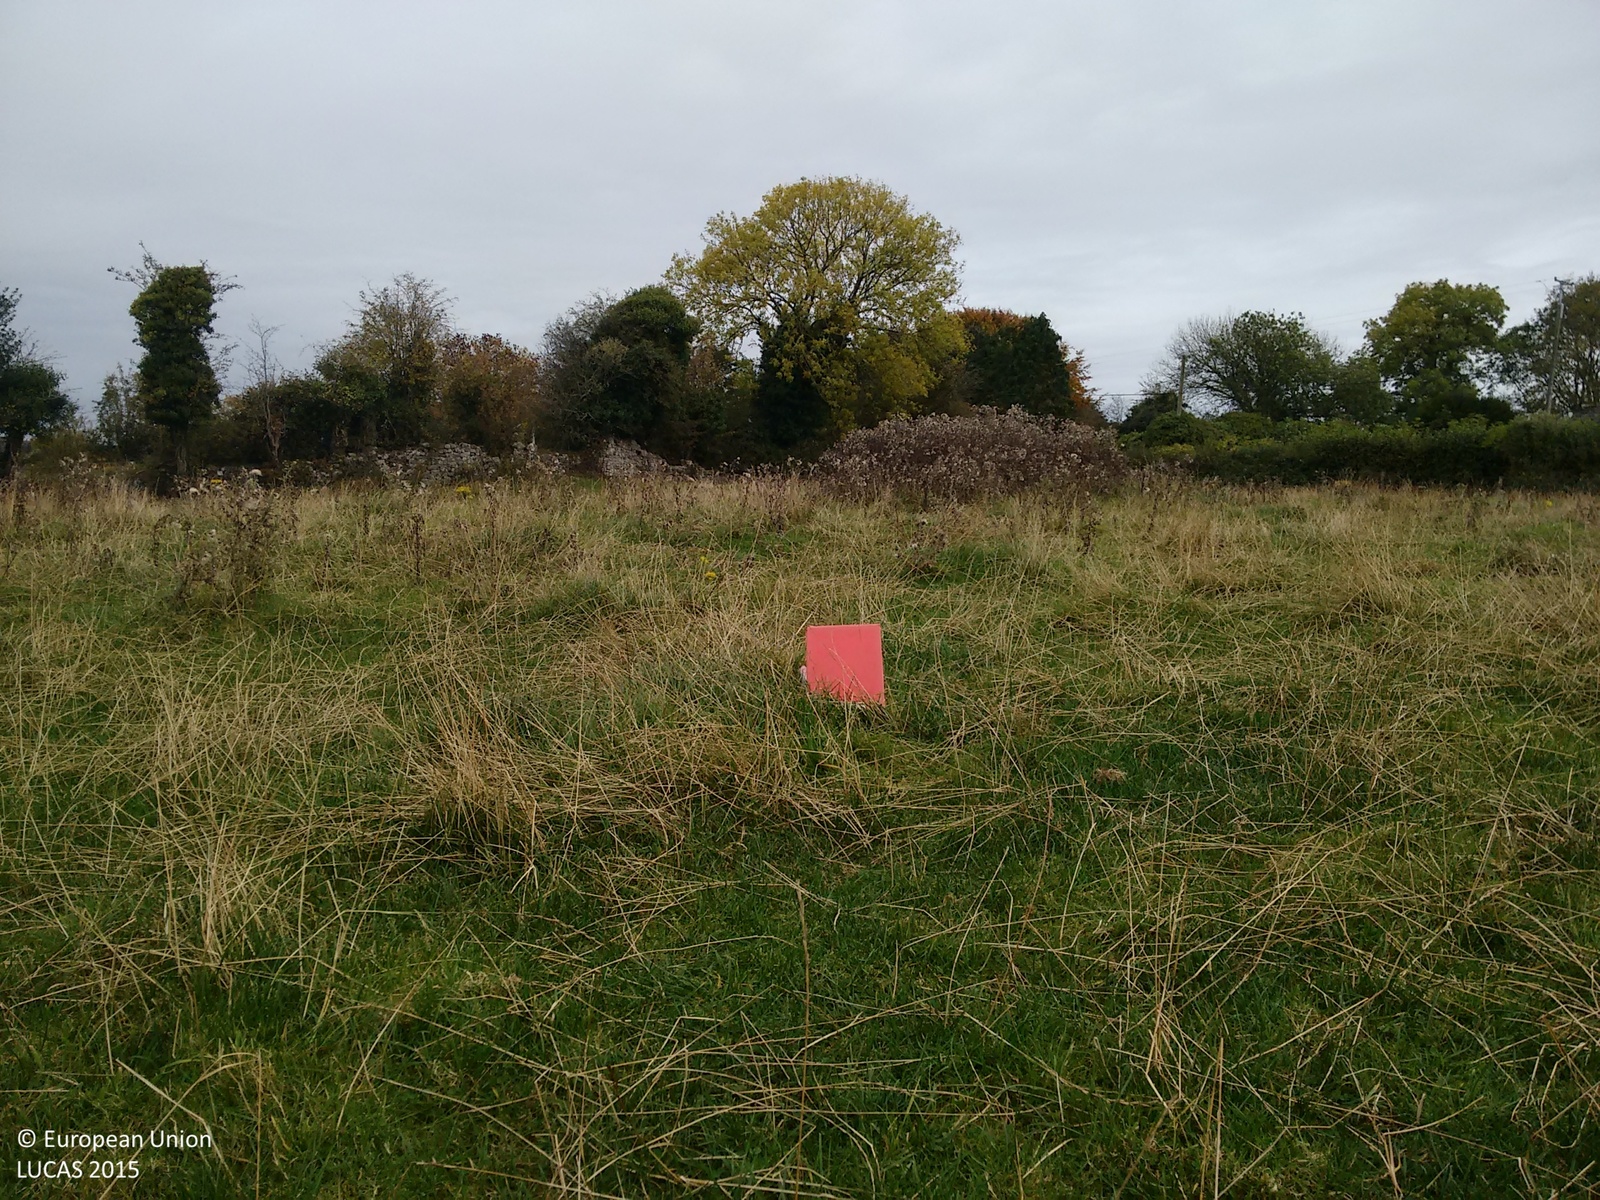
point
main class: Grassland
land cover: Grassland without tree/shrub cover
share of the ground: > 75 %
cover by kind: herbaceous plants 100 %
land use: Agriculture (excluding fallow land and kitchen gardens)
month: October
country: IE
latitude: 53.0815
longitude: -7.7995
